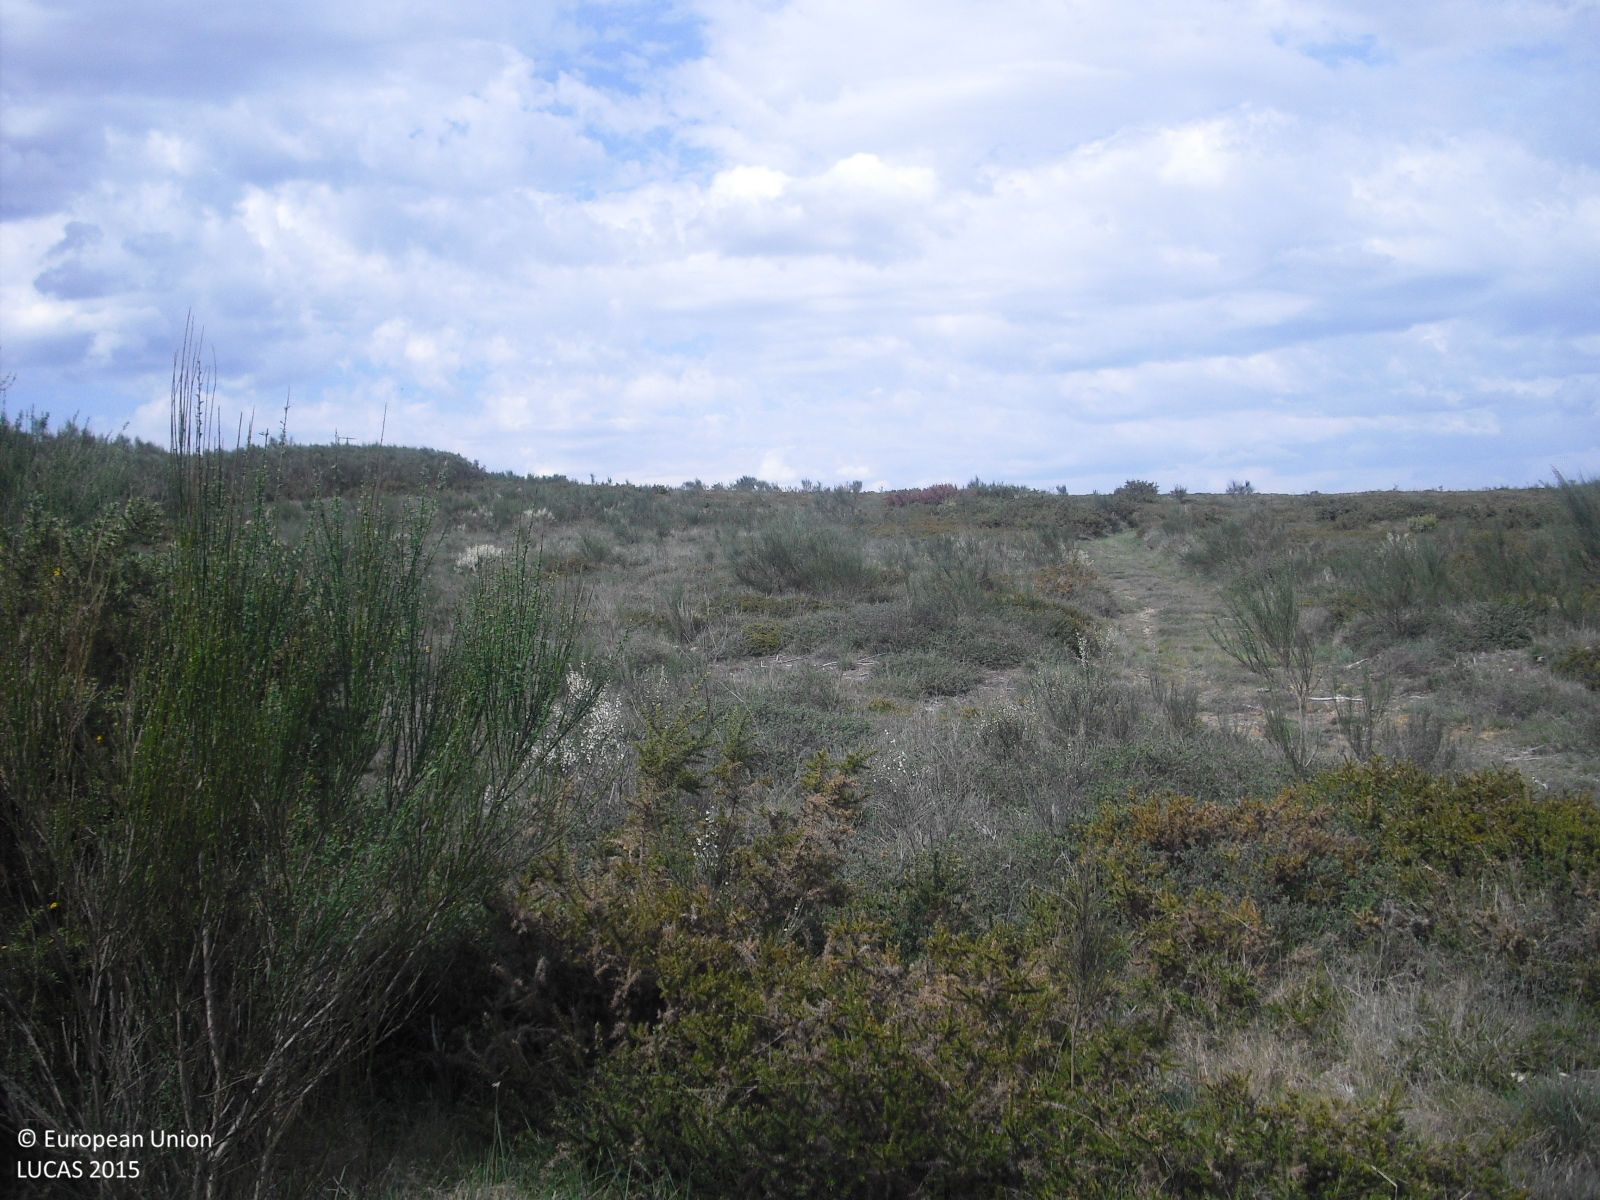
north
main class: Shrubland
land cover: Shrubland without tree cover
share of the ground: > 75 %
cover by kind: shrubs 90 %, herbaceous plants 10 %
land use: Semi-natural and natural areas not in use
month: April
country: ES
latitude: 41.9846
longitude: -7.8011
